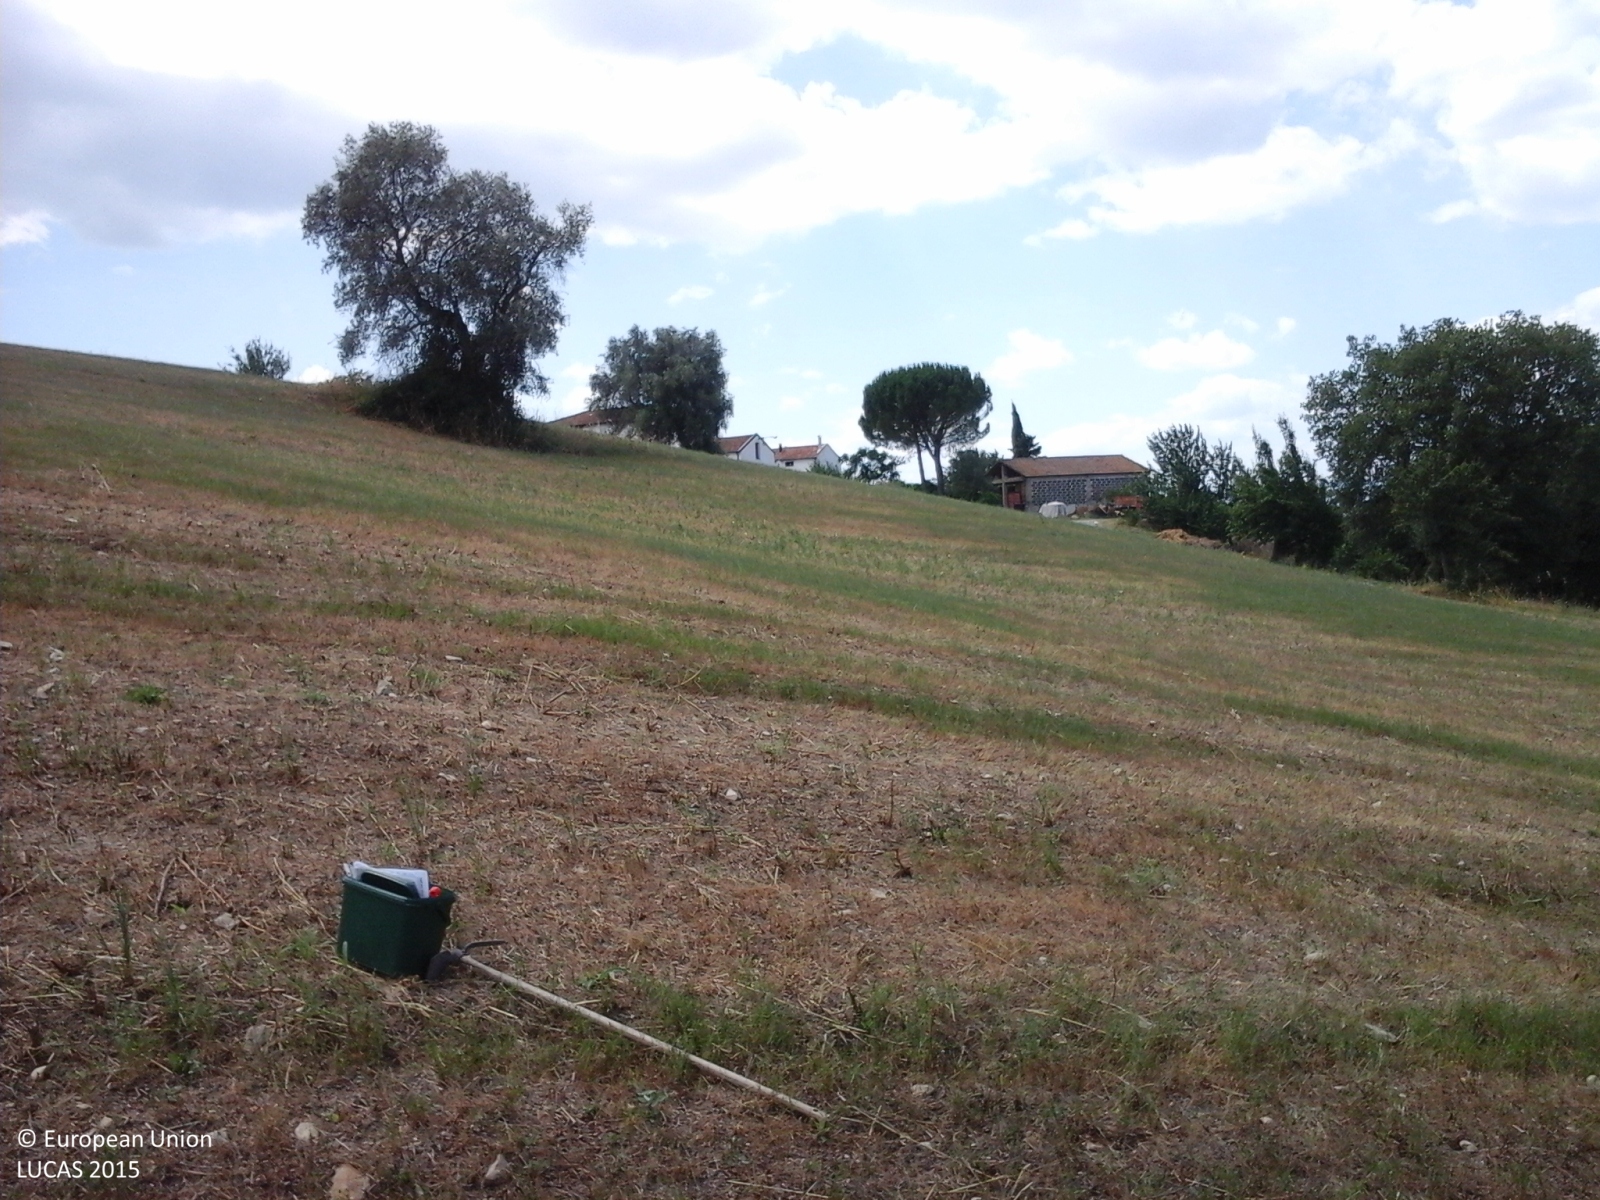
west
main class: Cropland
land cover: Temporary grasslands
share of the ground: > 75 %
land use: Agriculture (excluding fallow land and kitchen gardens)
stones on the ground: 10 - 25 %
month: June
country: IT
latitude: 40.4967
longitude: 15.1111
